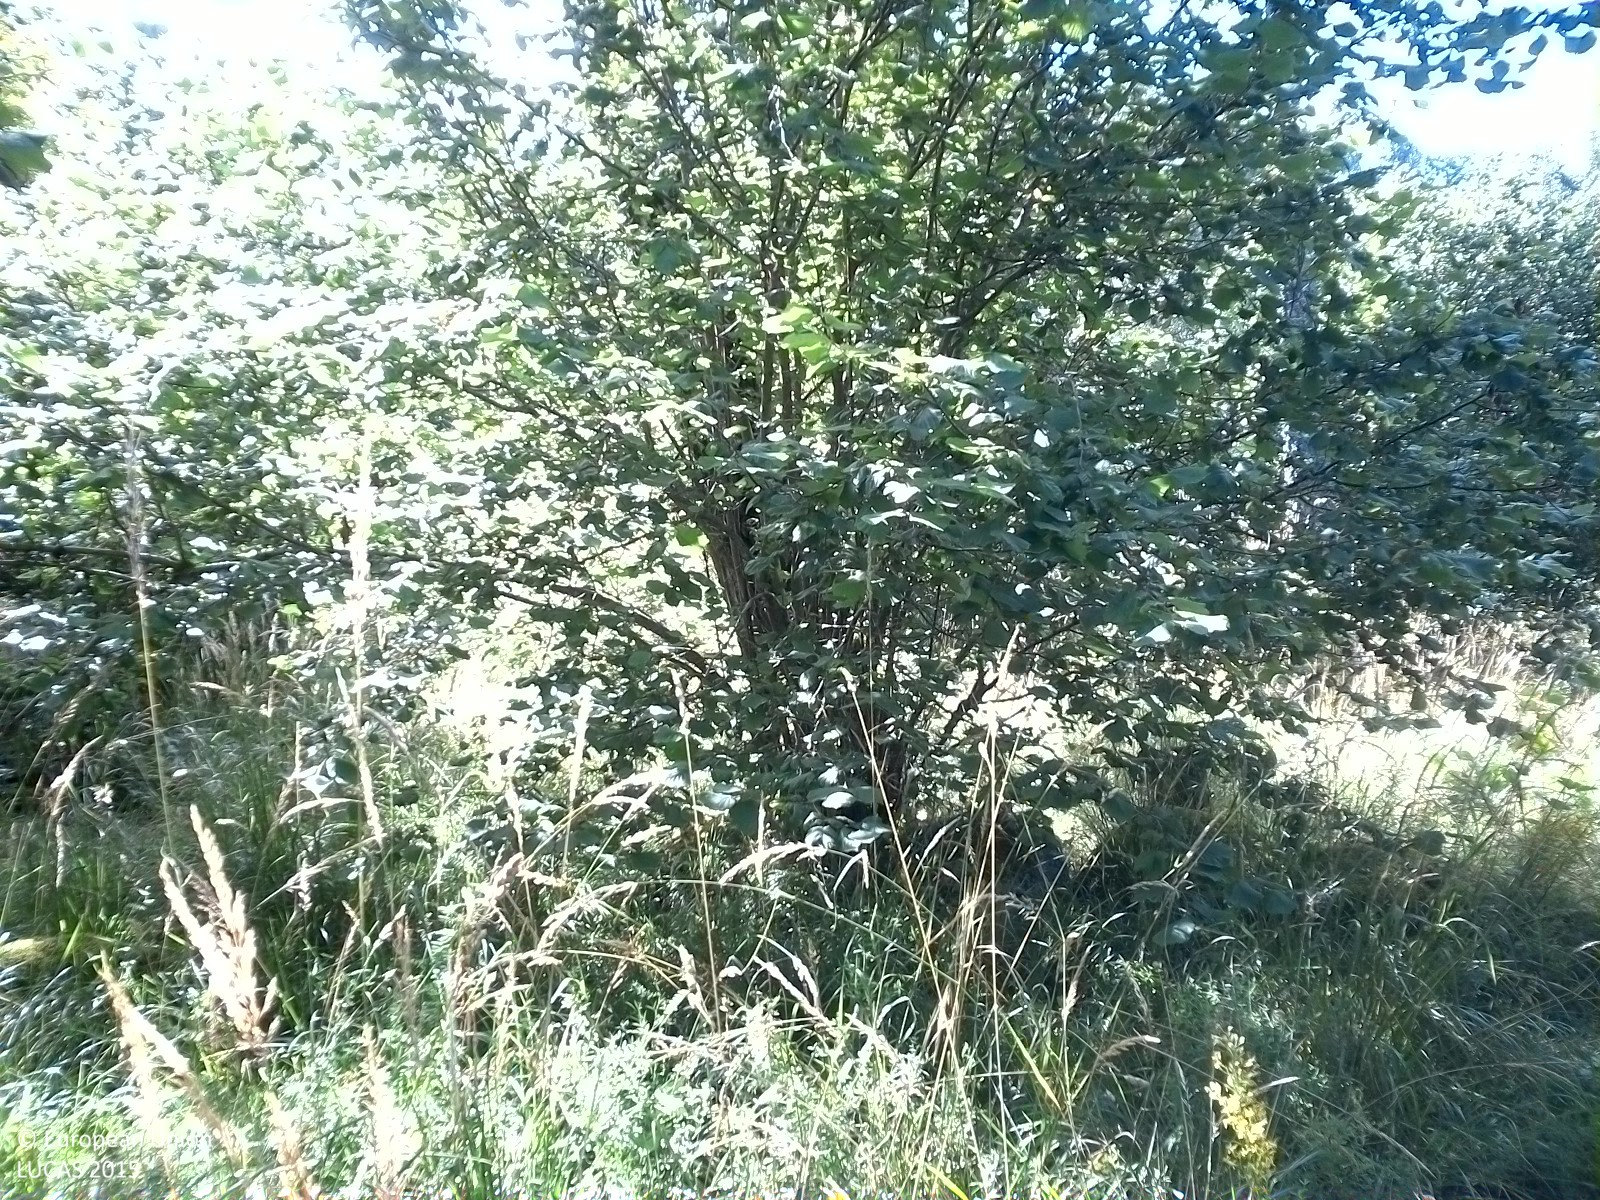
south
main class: Woodland
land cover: Broadleaved woodland
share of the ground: 25 - 50 %
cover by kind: broadleaved forest trees 45 %, herbaceous plants 40 %, shrubs 15 %
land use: Semi-natural and natural areas not in use
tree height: < 5 m
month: August
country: SE
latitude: 59.1672
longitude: 14.6273
